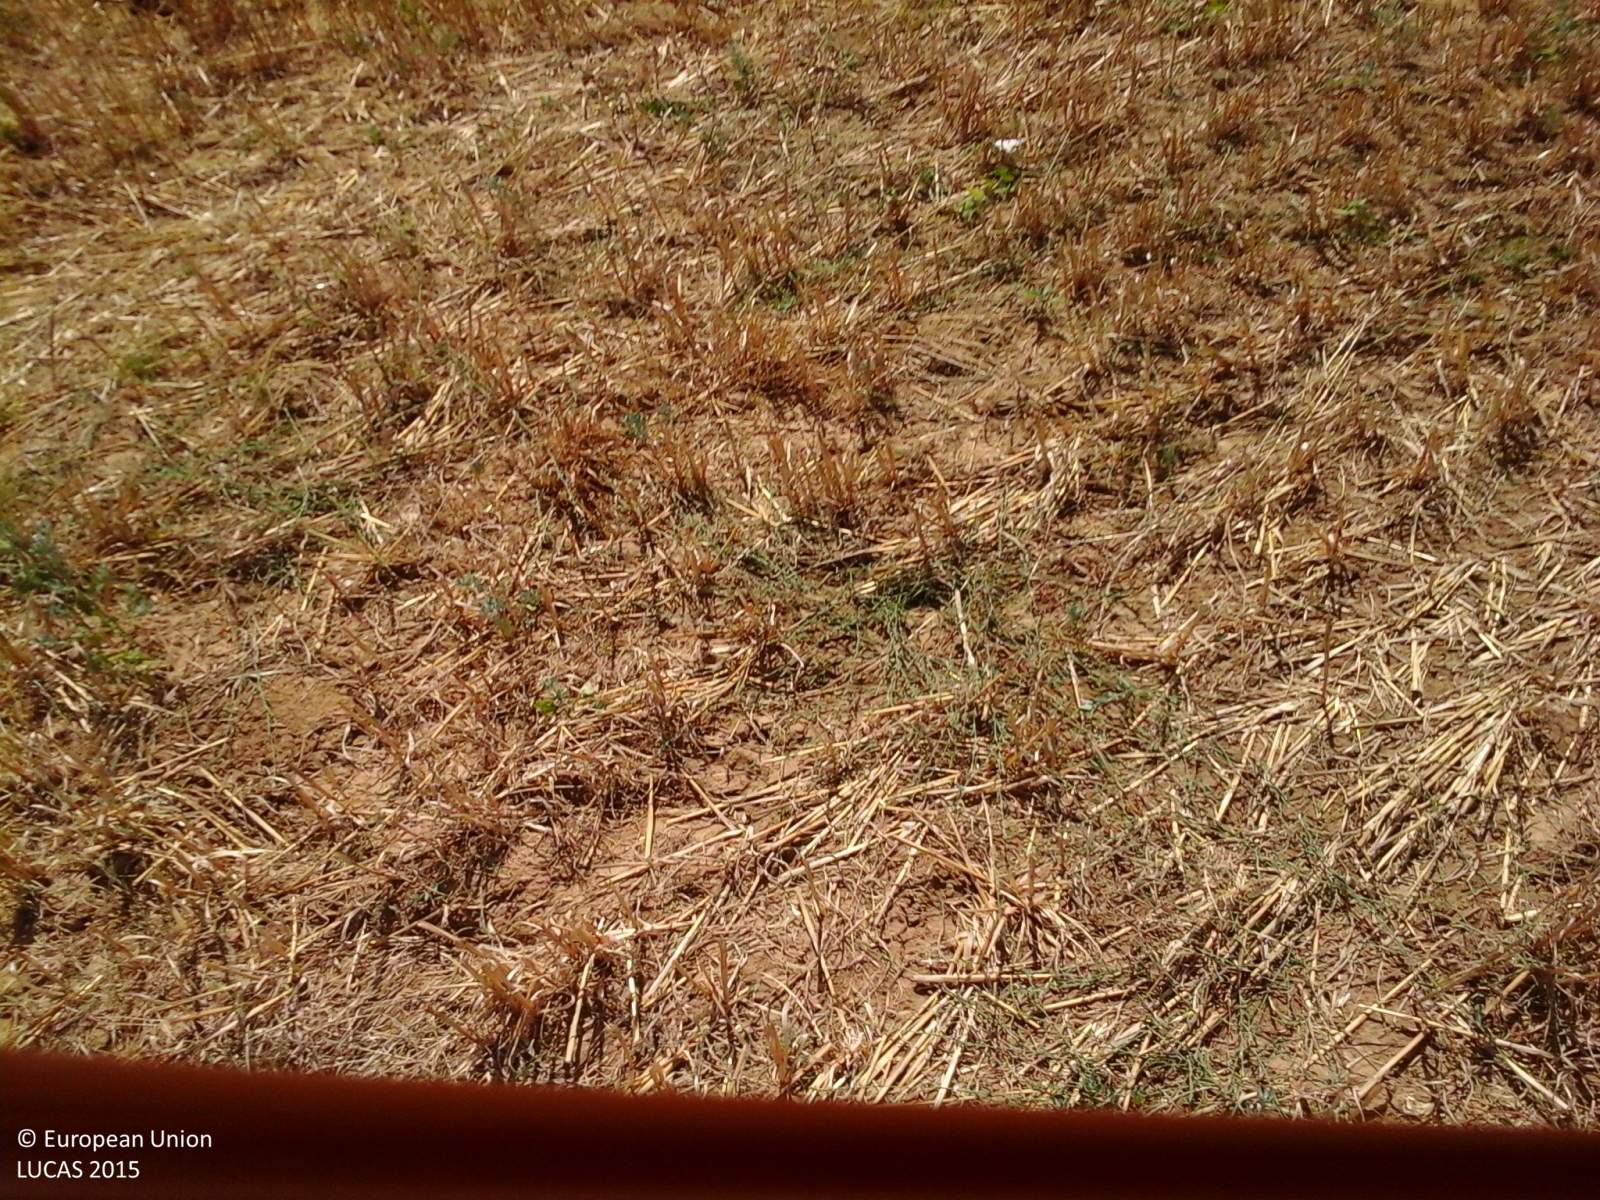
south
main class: Cropland
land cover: Barley
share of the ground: > 75 %
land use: Agriculture (excluding fallow land and kitchen gardens)
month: August
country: IT
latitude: 42.5354
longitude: 11.4439
